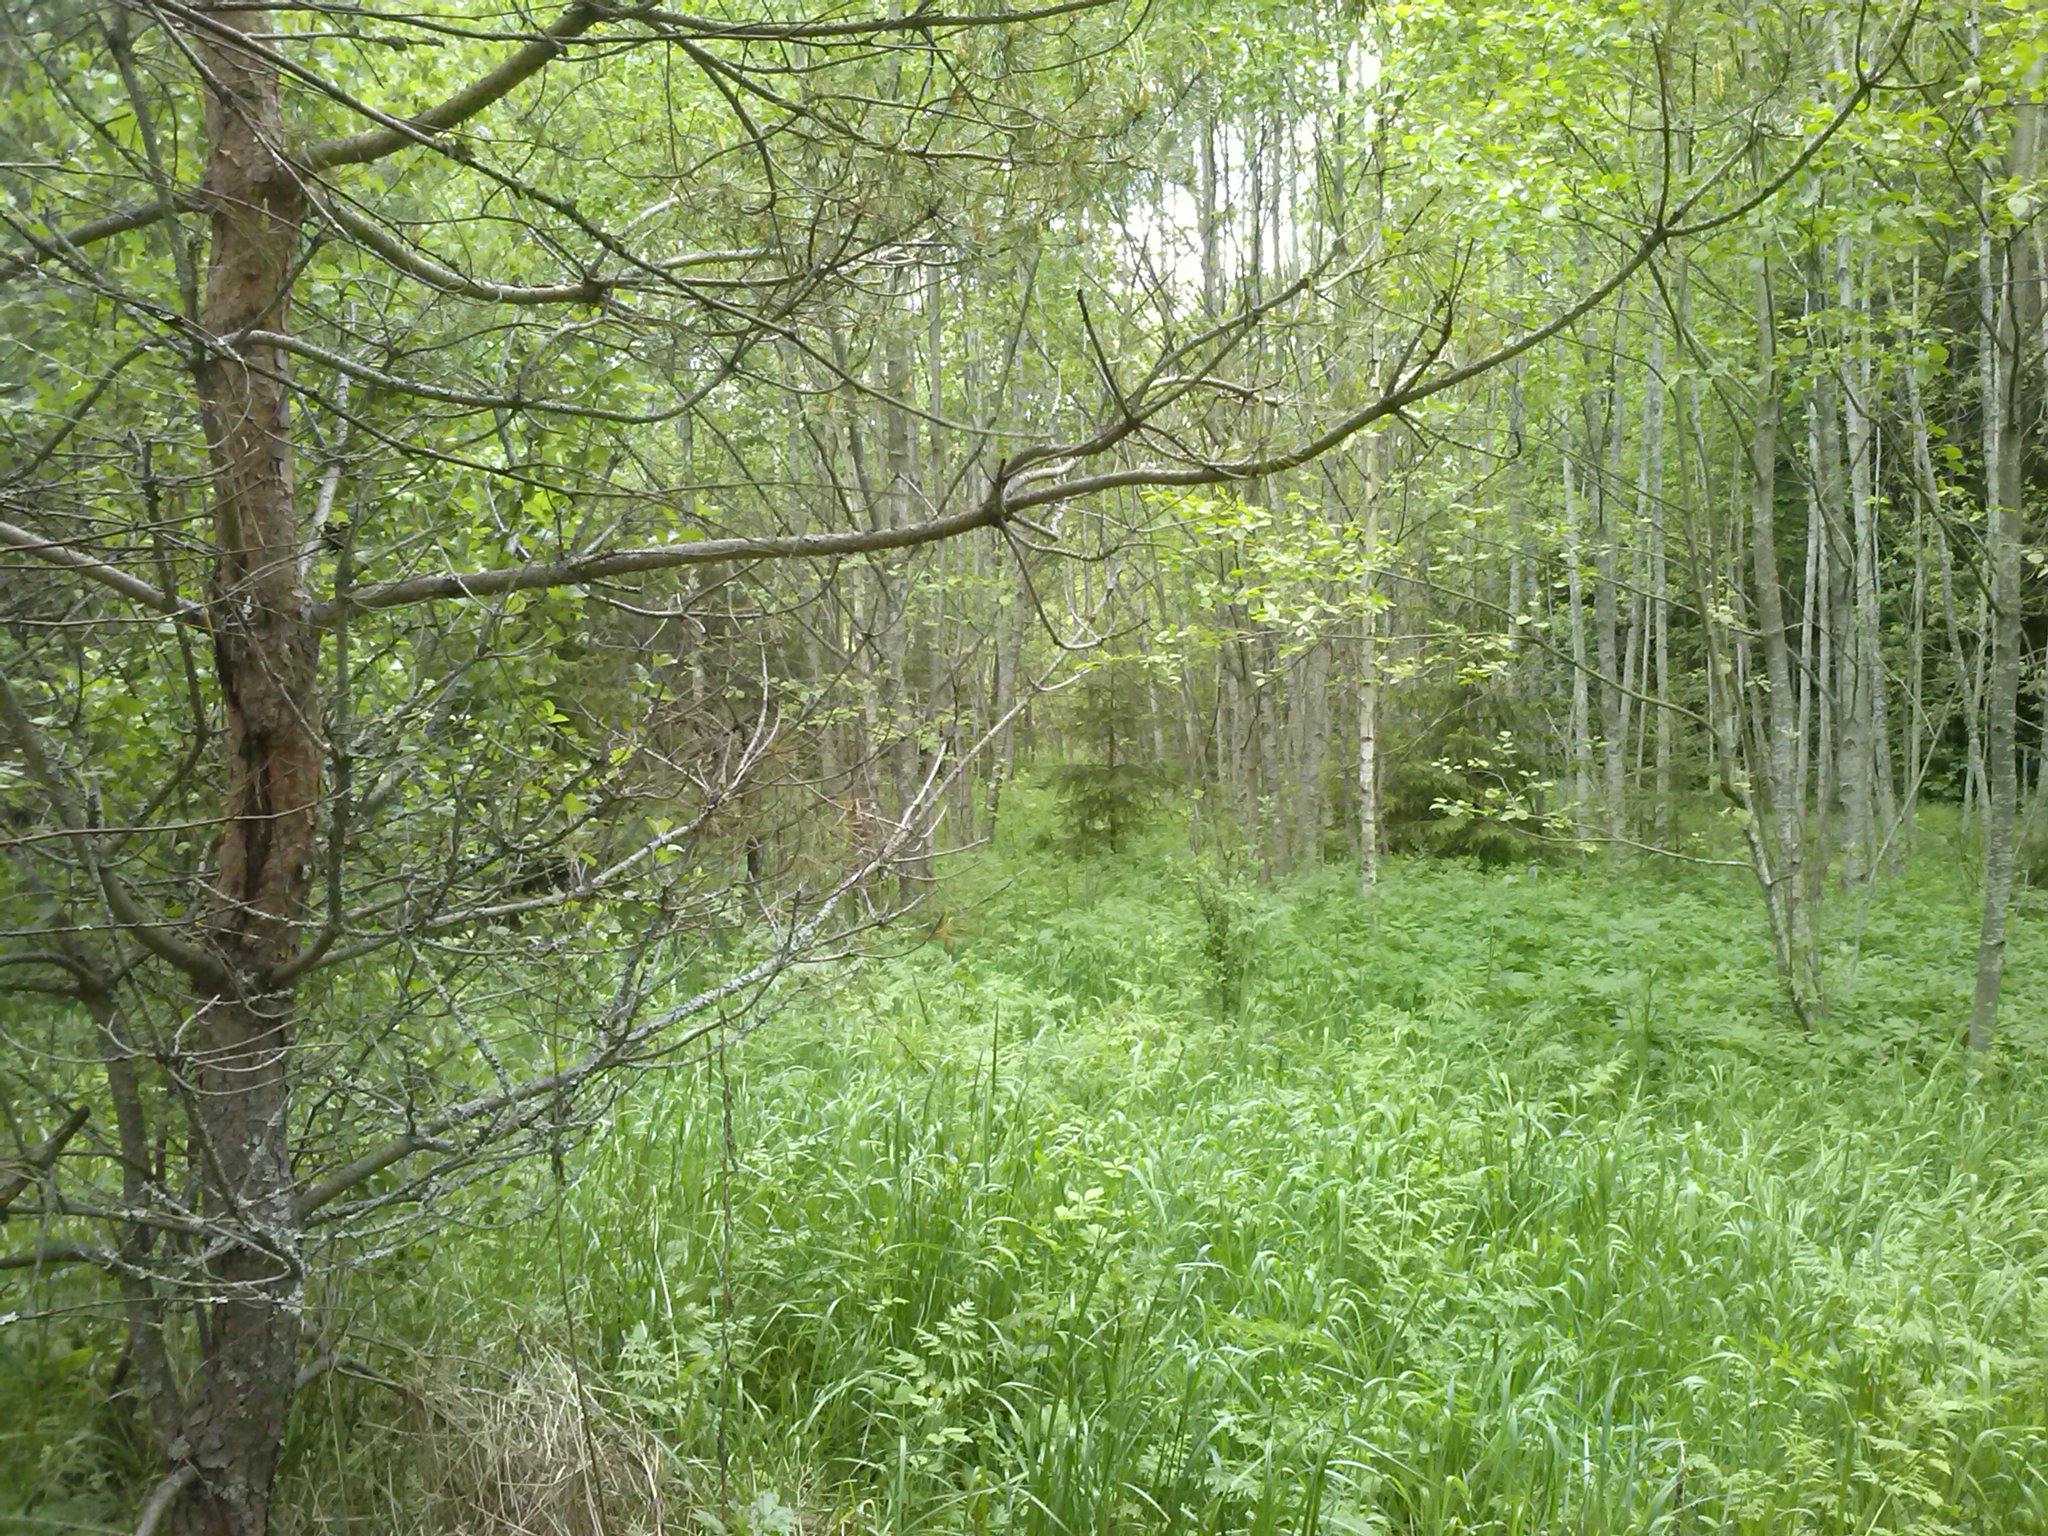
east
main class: Woodland
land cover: Other mixed woodland
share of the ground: > 75 %
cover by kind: coniferous forest trees 45 %, broadleaved forest trees 30 %, herbaceous plants 25 %
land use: Forestry
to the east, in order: Other mixed woodland; Spruce dominated mixed woodland; Spontaneously vegetated surfaces; Broadleaved woodland; Grassland with sparse tree/shrub cover; Broadleaved woodland; Spruce dominated mixed woodland; Broadleaved woodland
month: May
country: LV
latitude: 56.1923
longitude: 27.7380
